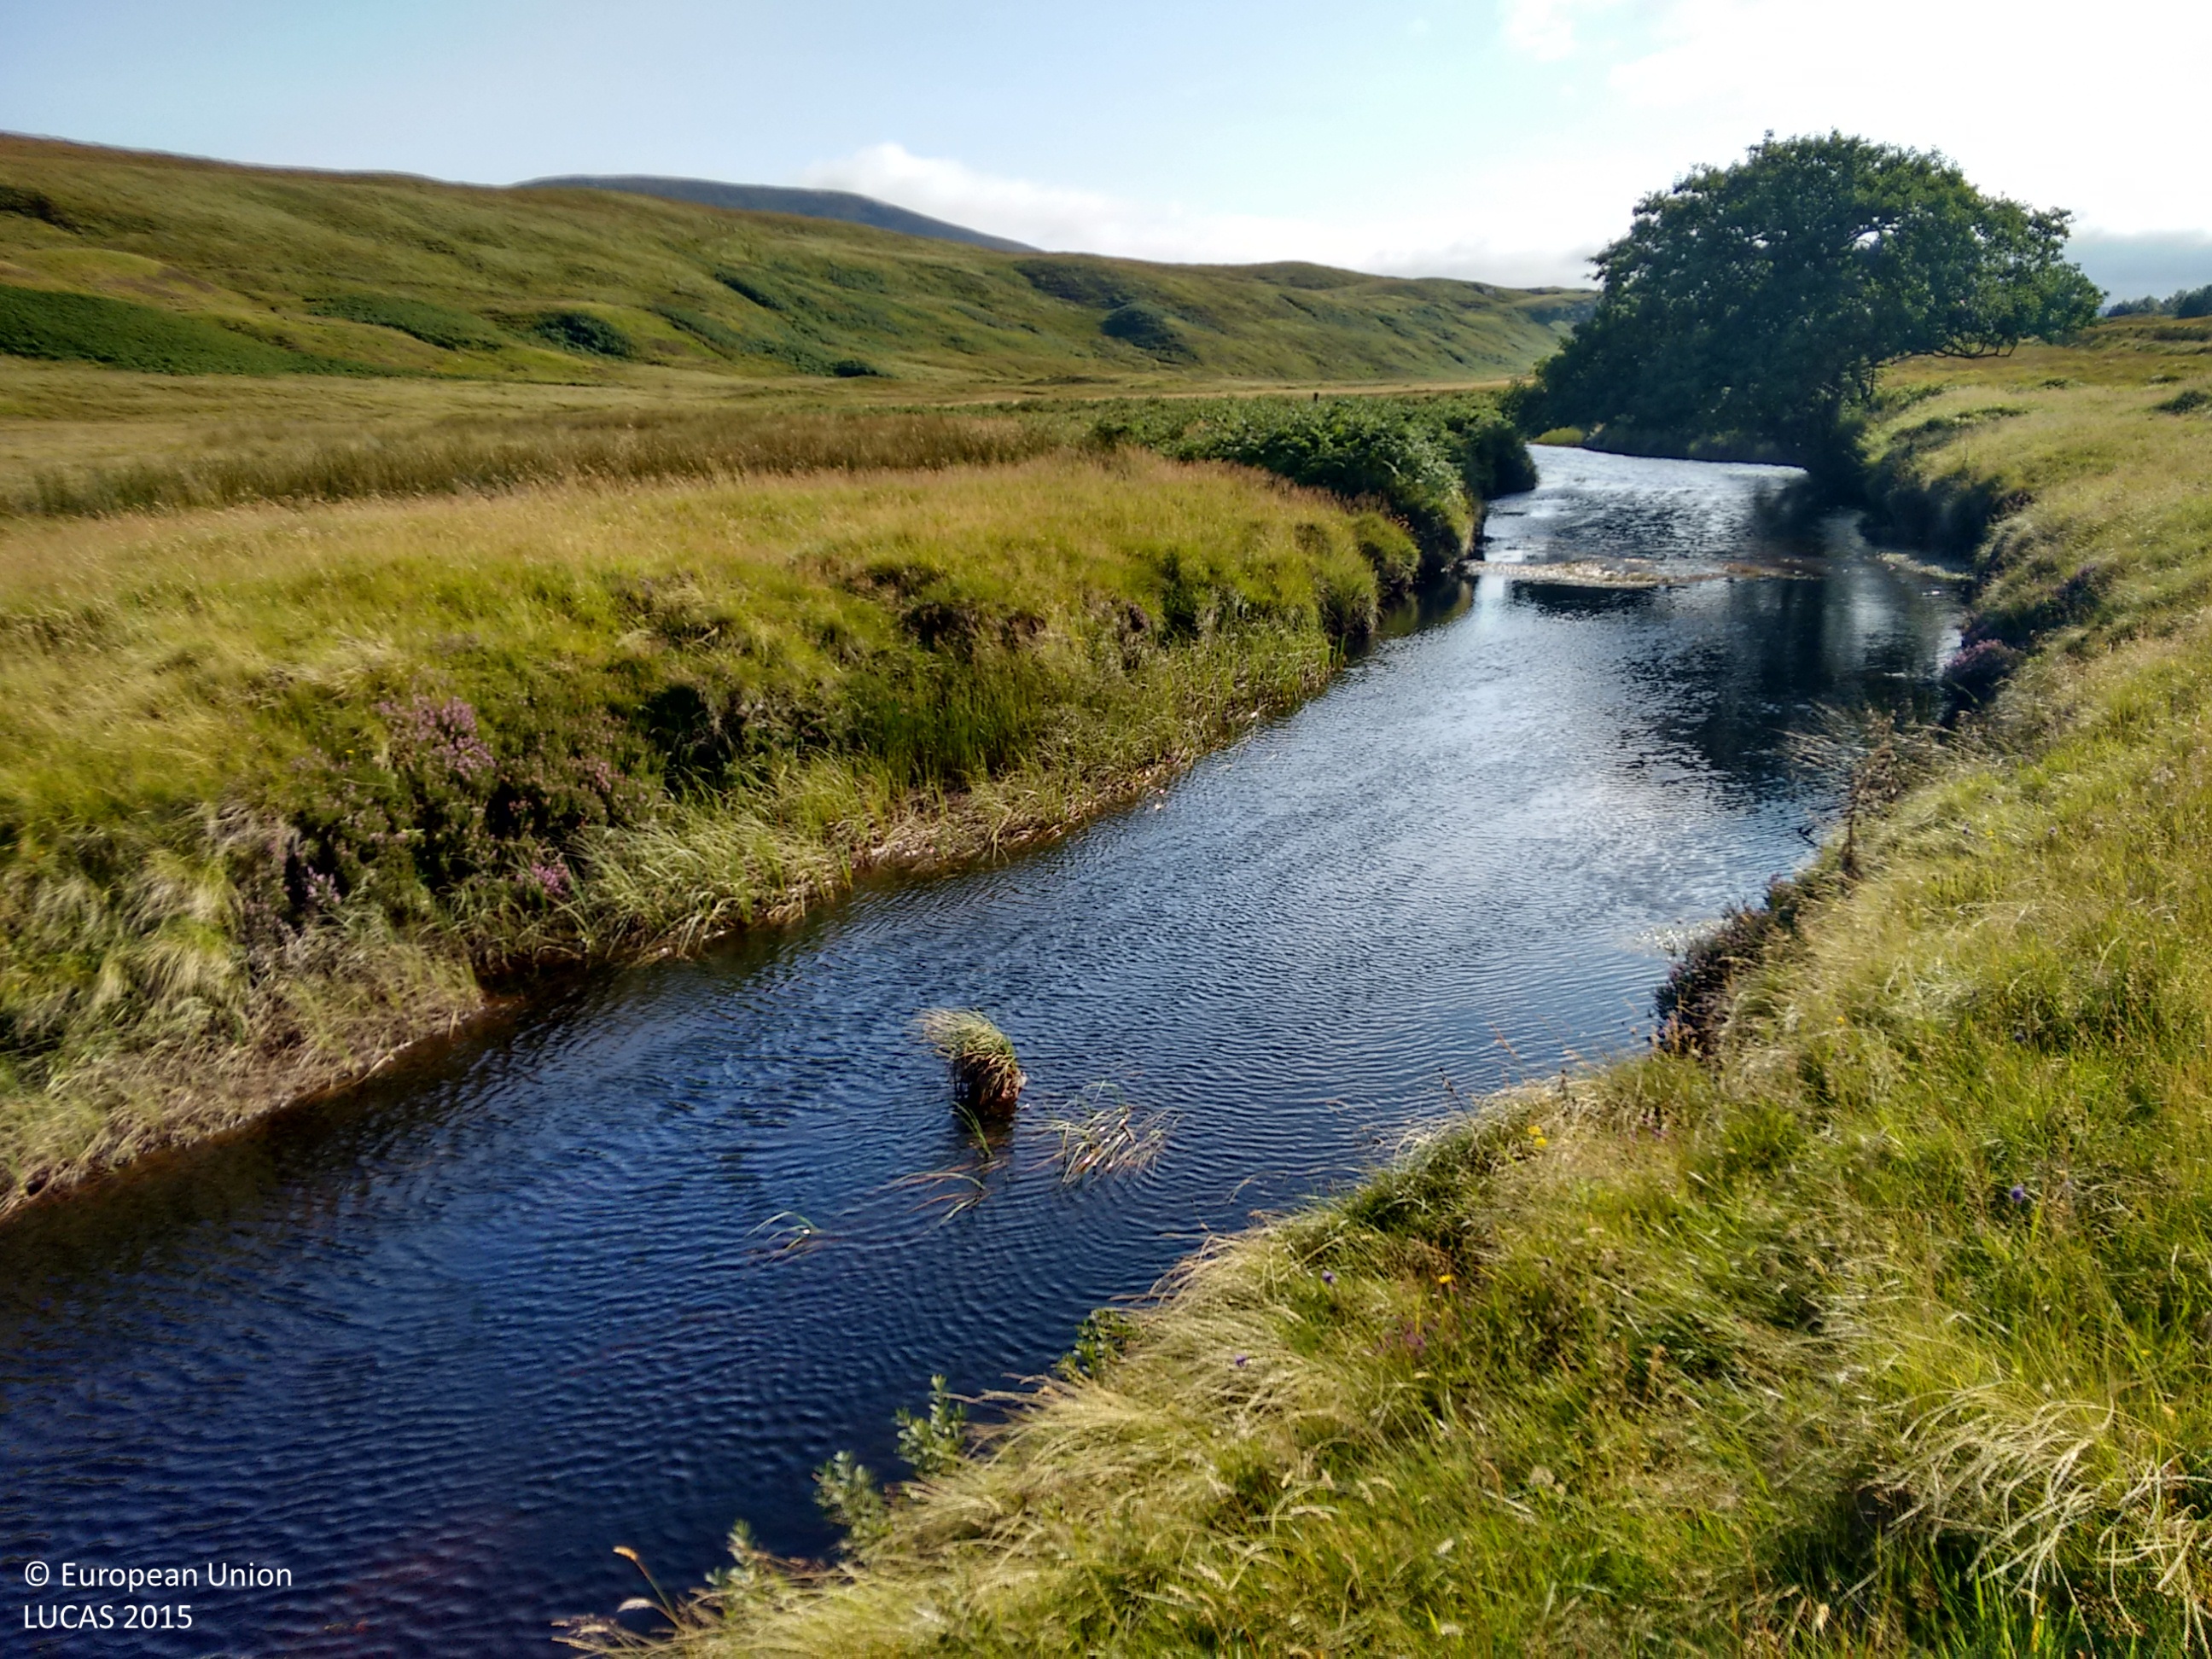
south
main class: Grassland
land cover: Grassland without tree/shrub cover
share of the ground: > 75 %
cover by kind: herbaceous plants 100 %
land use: Agriculture (excluding fallow land and kitchen gardens)
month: September
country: GB
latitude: 58.2359
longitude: -4.4778
